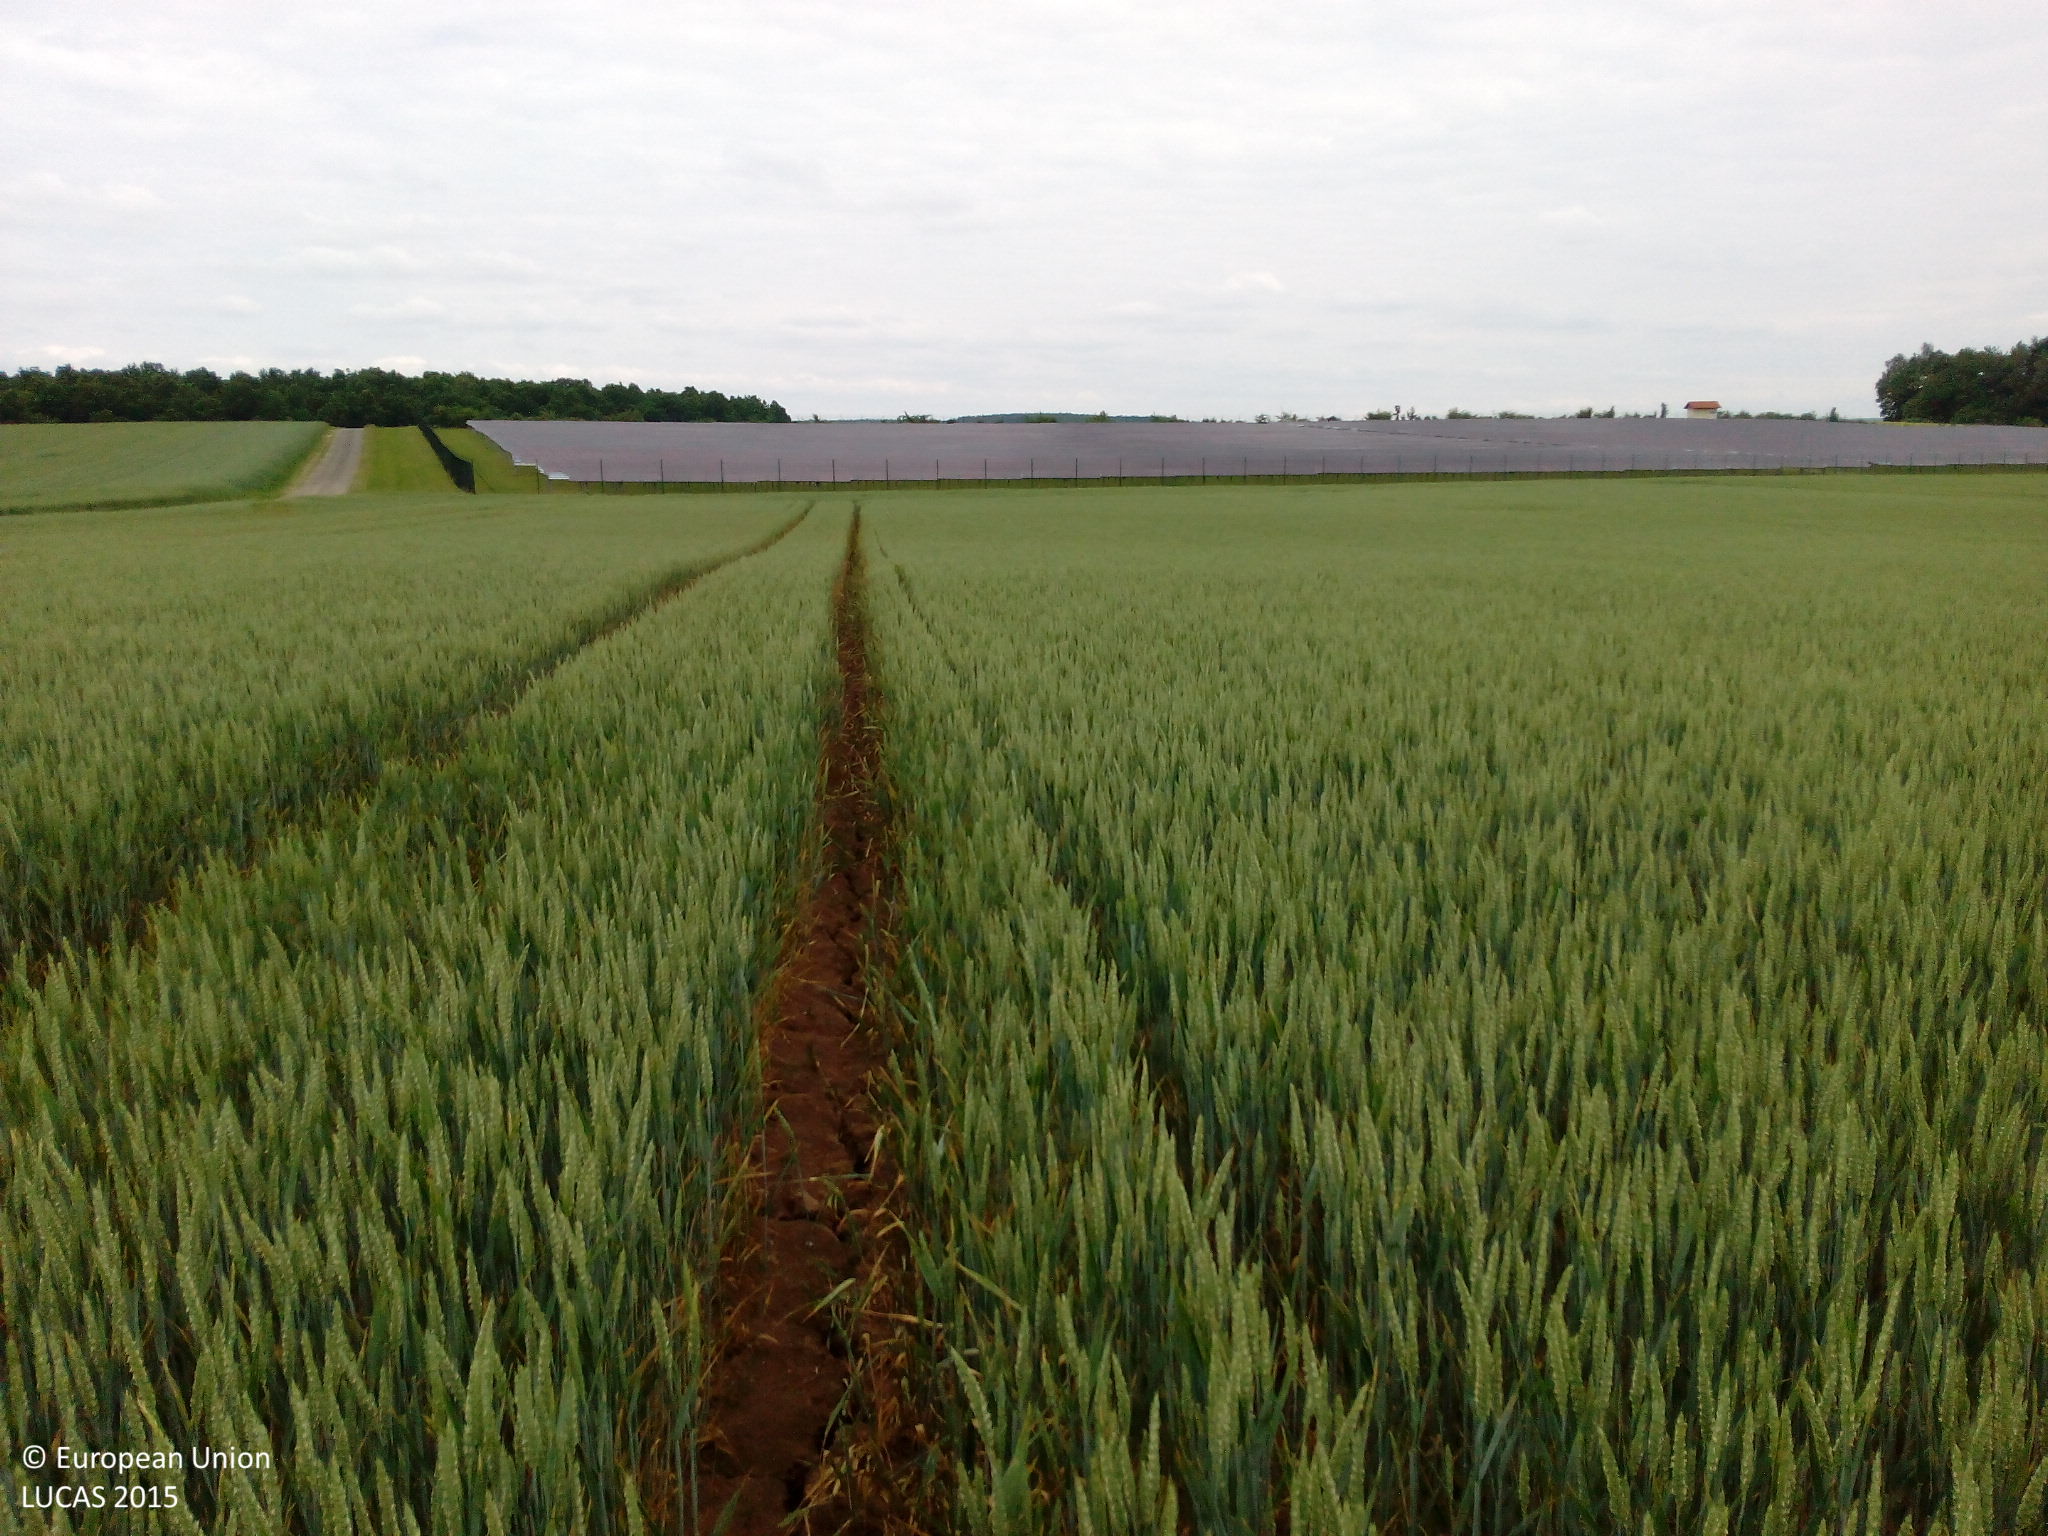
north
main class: Cropland
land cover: Common wheat
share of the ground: > 75 %
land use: Agriculture (excluding fallow land and kitchen gardens)
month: June
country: DE
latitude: 50.2556
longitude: 10.3505
